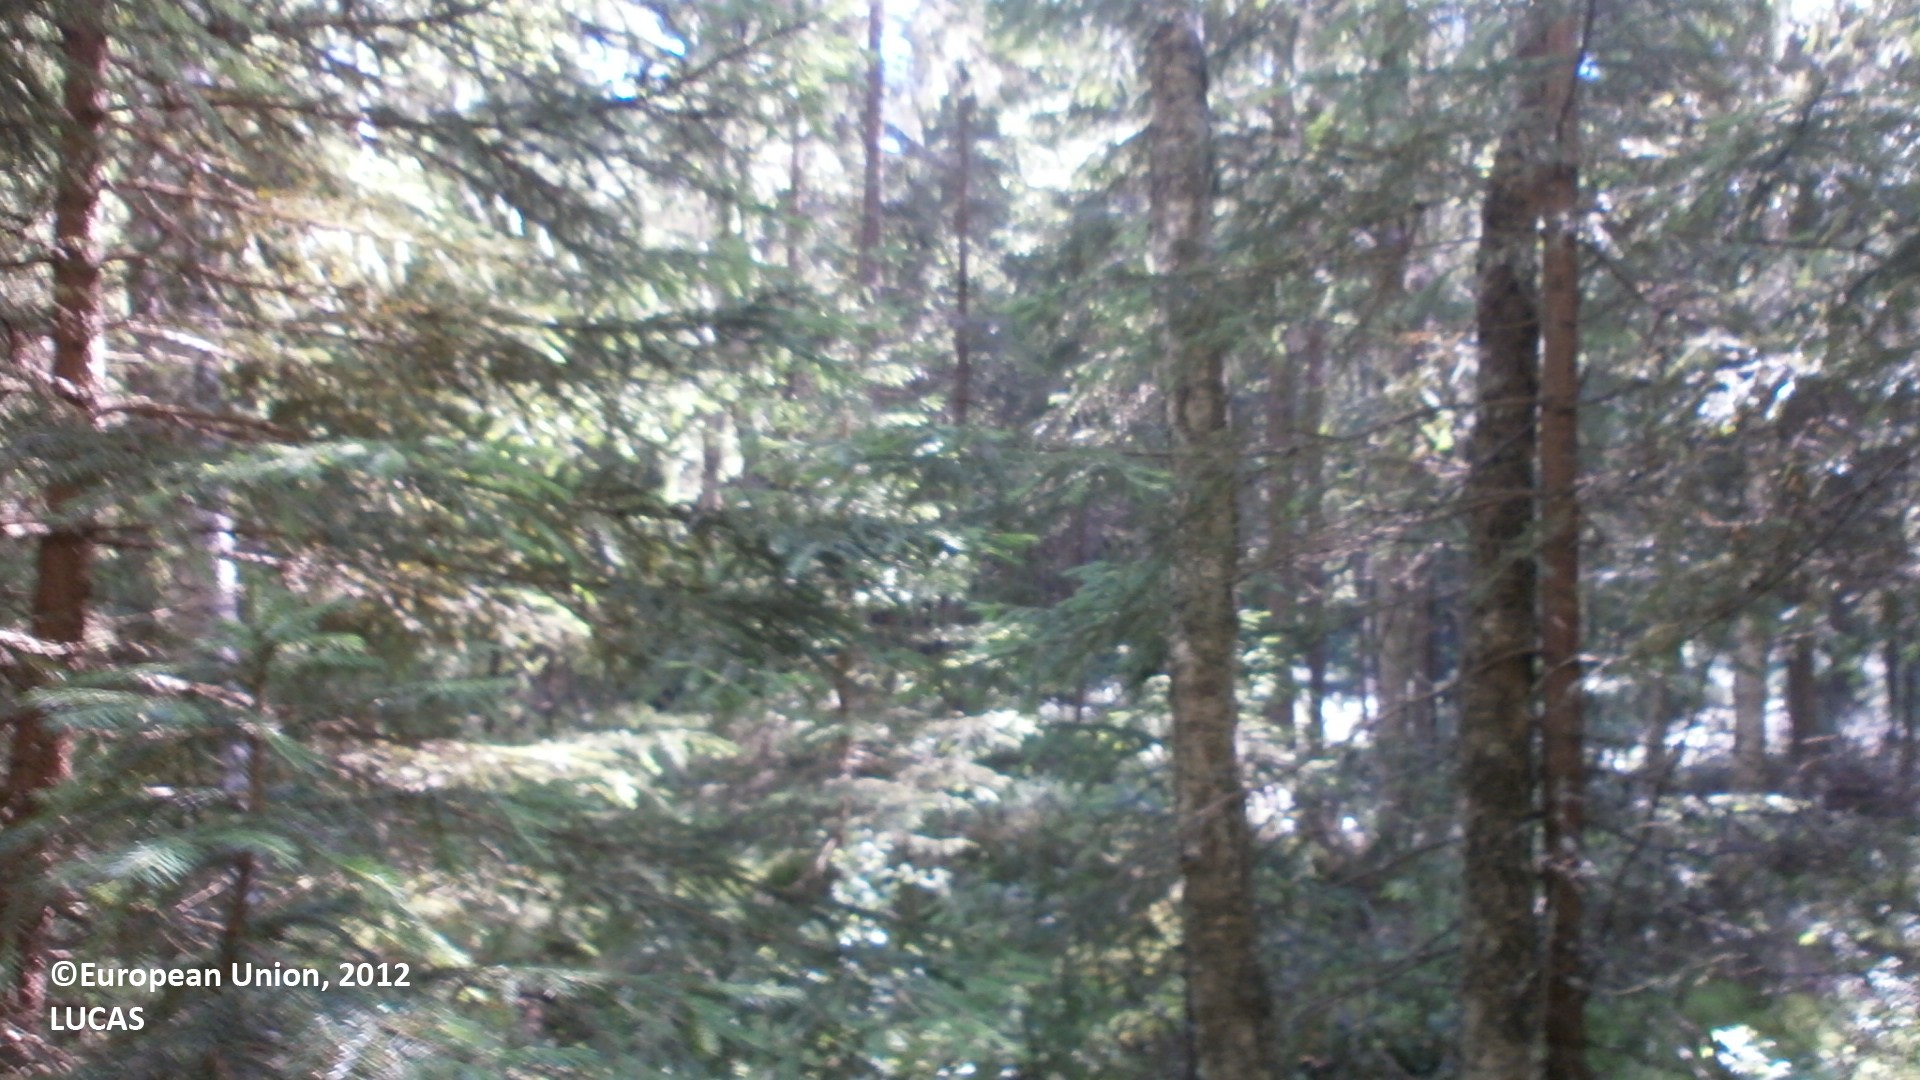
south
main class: Woodland
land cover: Spruce dominated coniferous woodland
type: boreal forest
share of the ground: > 75 %
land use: Forestry
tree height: > 5 m
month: July
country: FI
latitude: 64.3307
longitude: 23.9443
